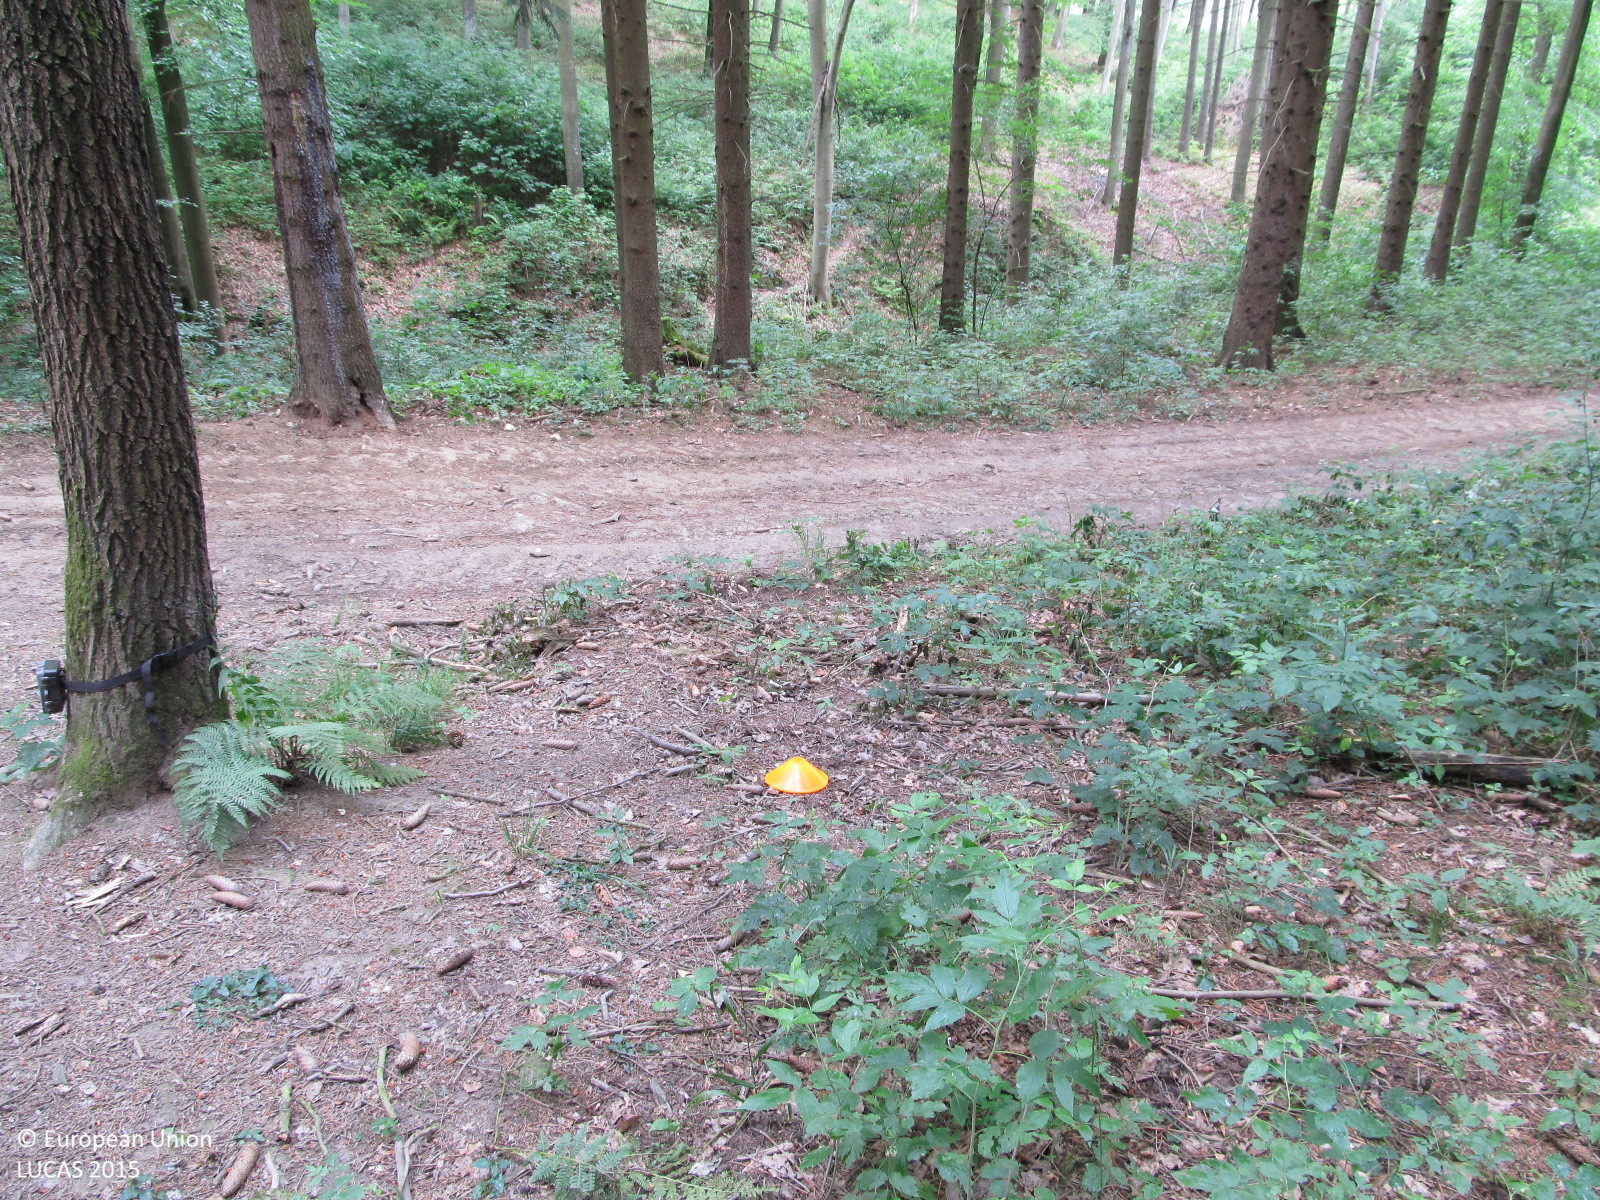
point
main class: Woodland
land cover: Spruce dominated mixed woodland
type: mountainous beech forest
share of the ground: > 75 %
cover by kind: coniferous forest trees 60 %, broadleaved forest trees 25 %, unconsolidated bare surface 10 %, shrubs 5 %
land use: Forestry
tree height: > 5 m
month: July
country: AT
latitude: 48.8260
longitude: 15.8477
